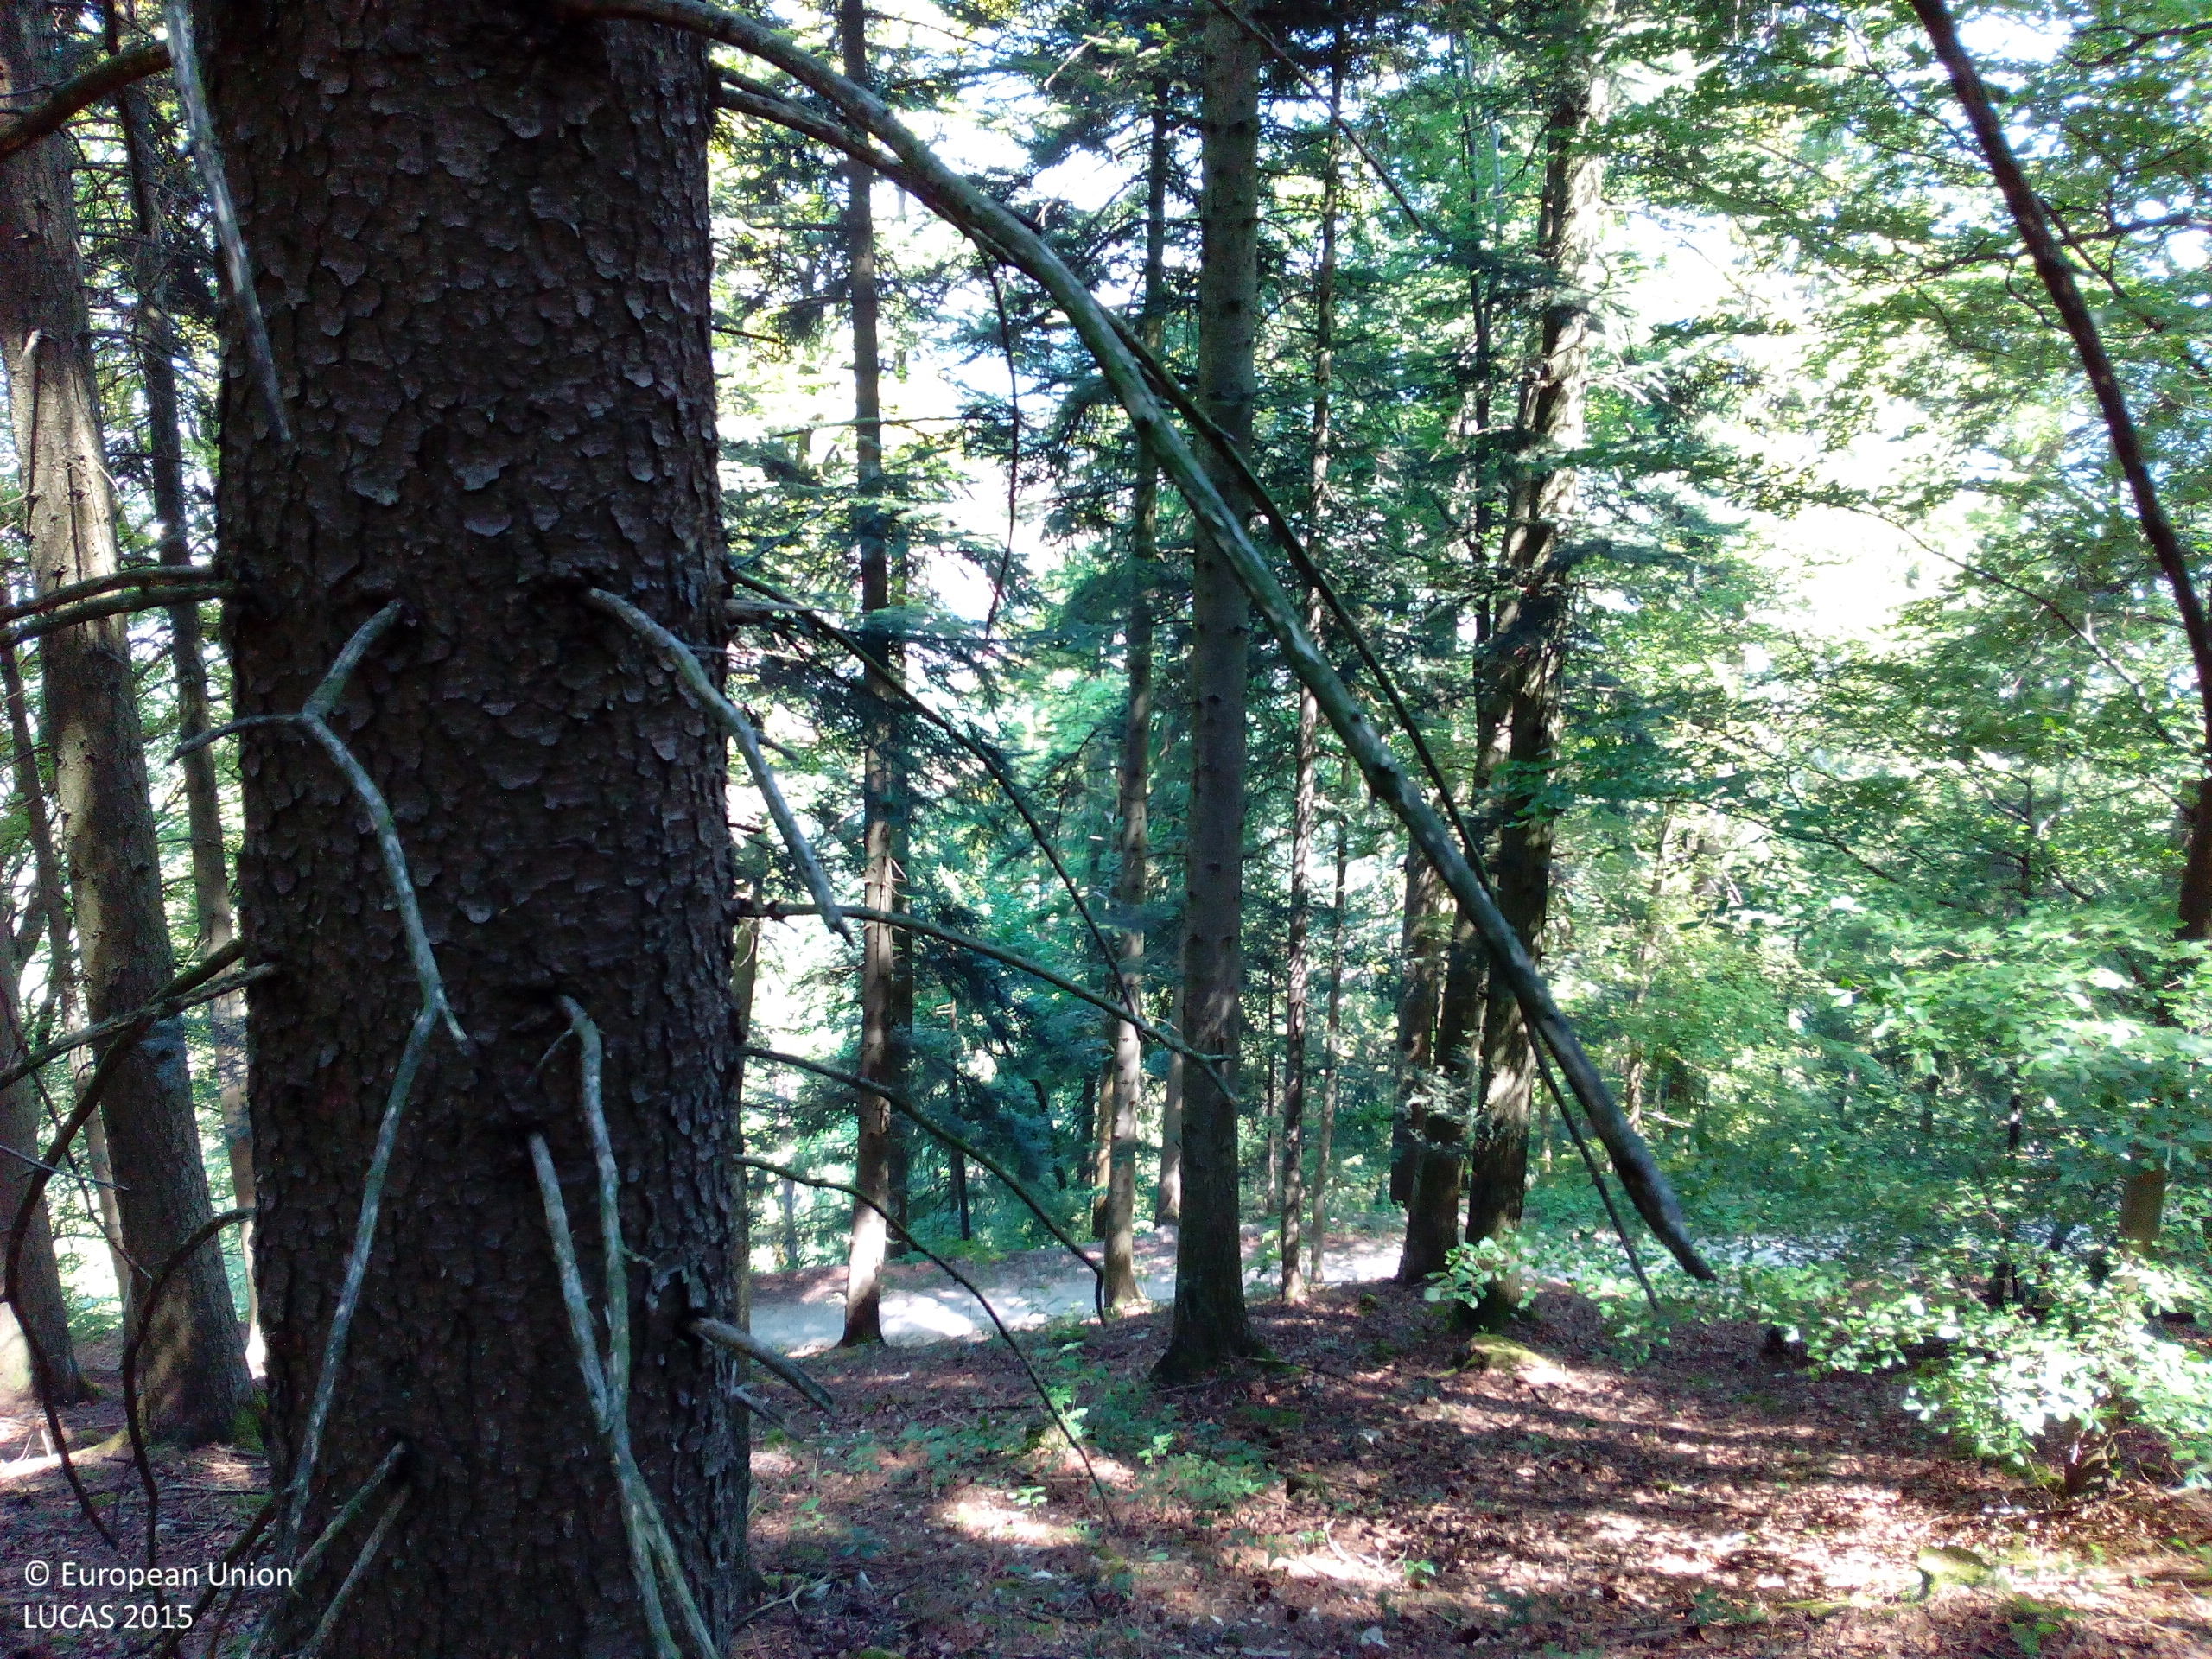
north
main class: Woodland
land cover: Other mixed woodland
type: beech forest
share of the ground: > 75 %
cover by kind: coniferous forest trees 45 %, broadleaved forest trees 35 %, lichens and mosses 10 %, unconsolidated bare surface 10 %
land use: Forestry
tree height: > 5 m
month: July
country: DE
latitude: 48.0545
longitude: 8.7530
